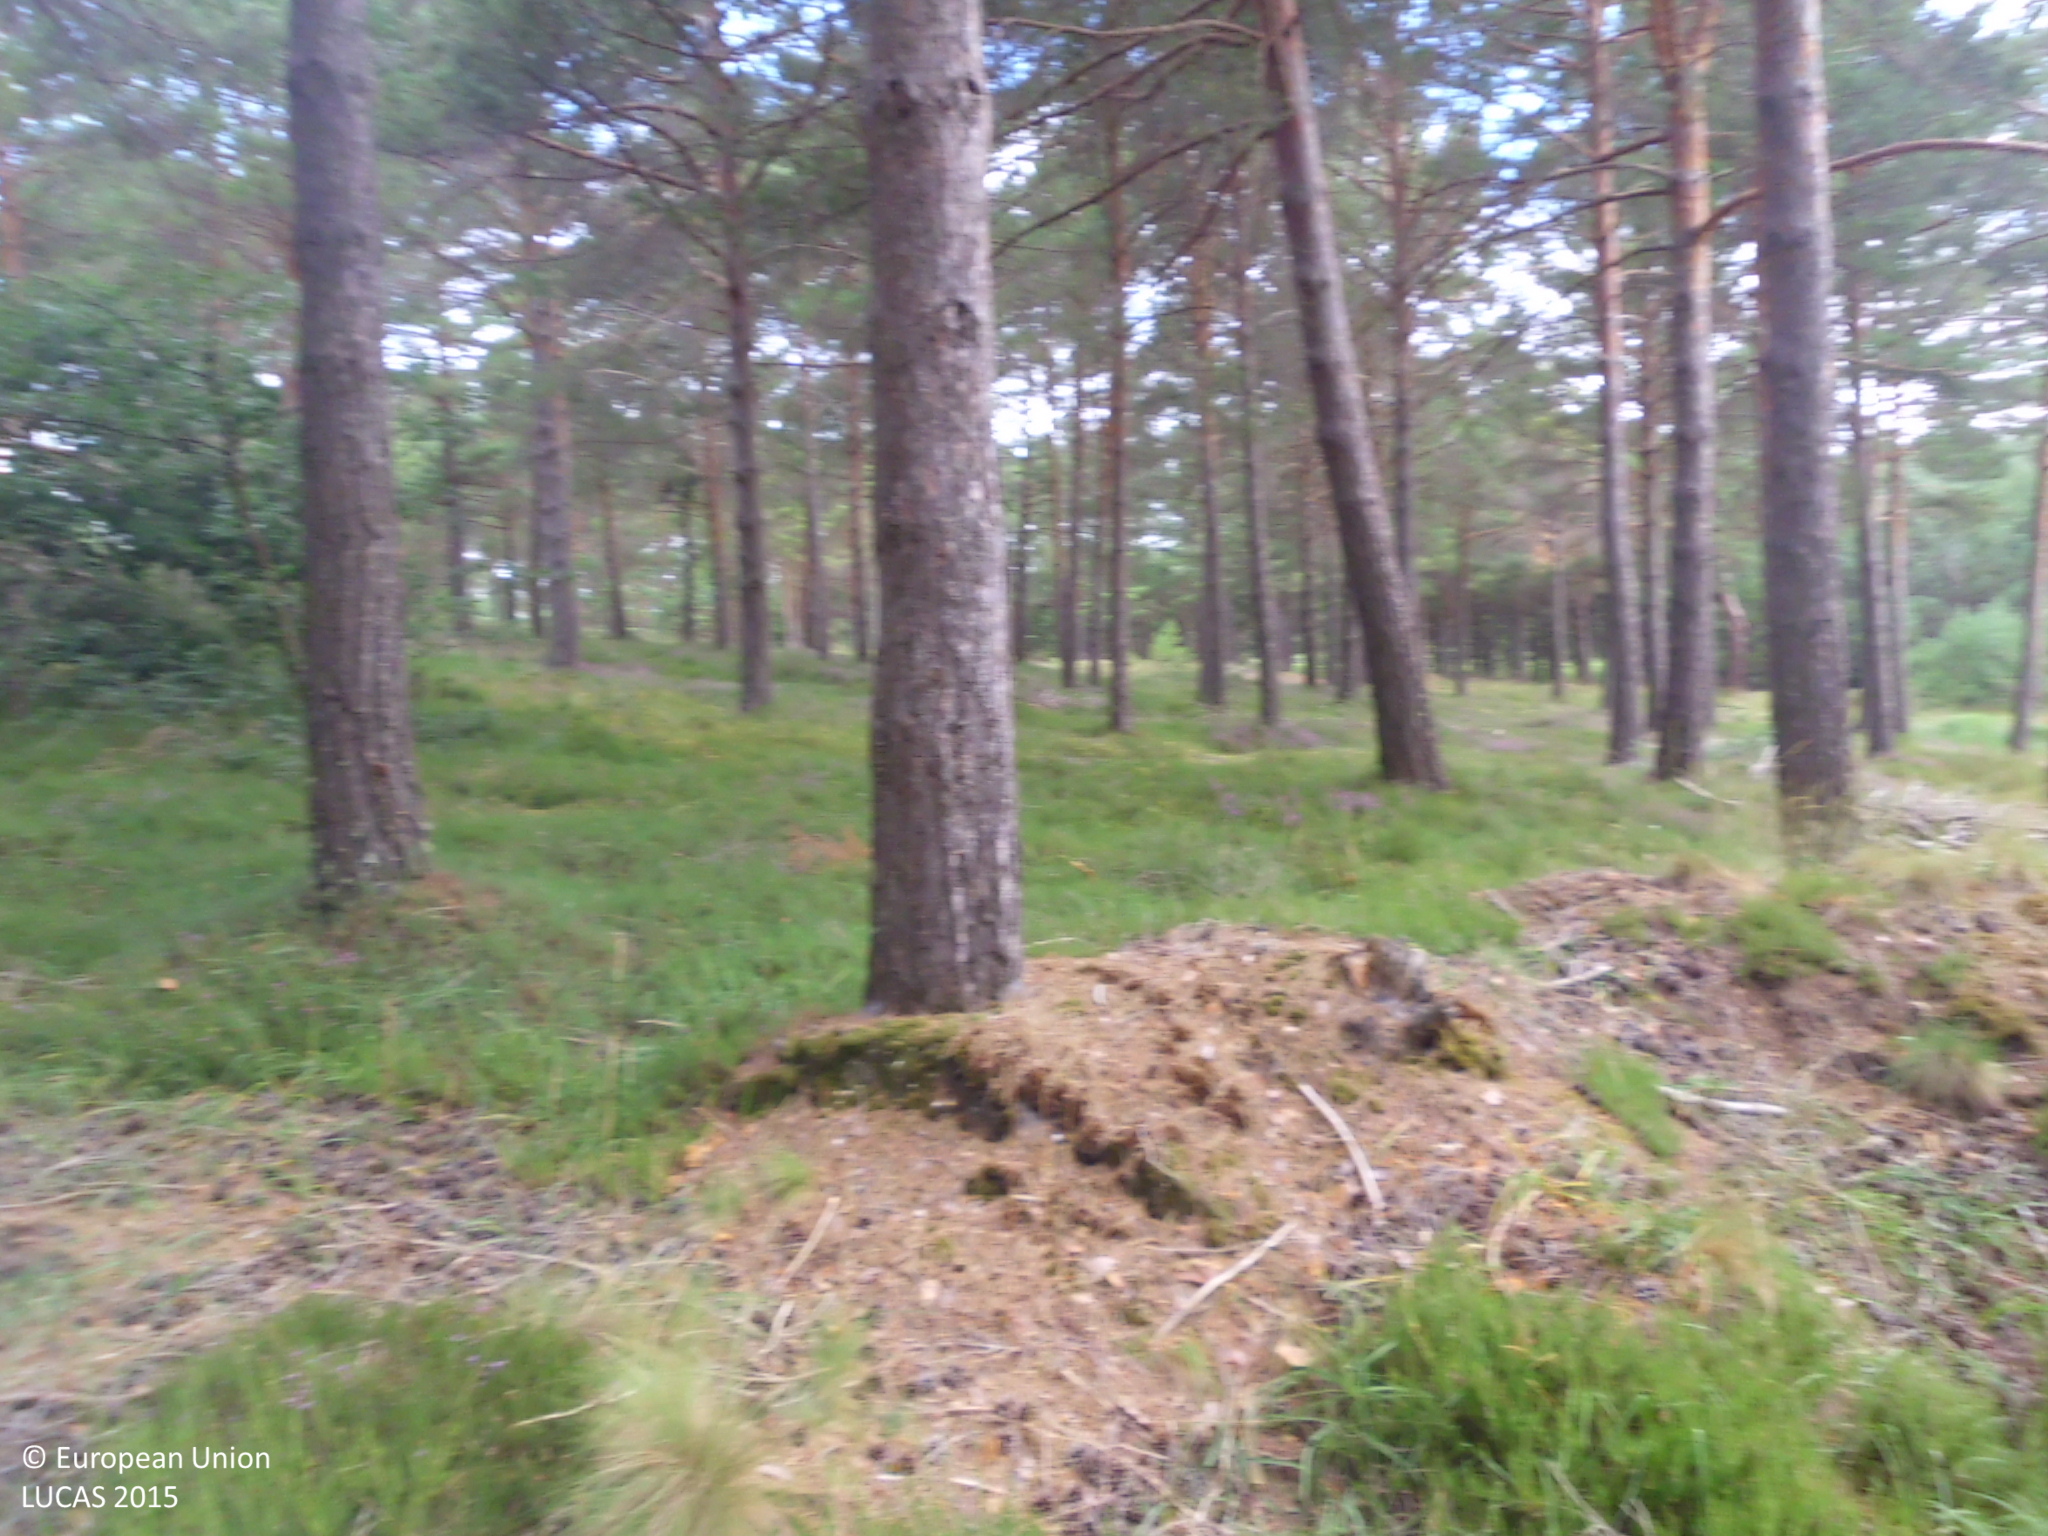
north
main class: Woodland
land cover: Pine dominated coniferous woodland
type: coniferous forest of the mediterranean region
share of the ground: > 75 %
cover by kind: coniferous forest trees 80 %, consolidated bare surface 15 %, shrubs 5 %
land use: Forestry
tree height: > 5 m
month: July
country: ES
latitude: 42.6835
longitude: -3.9940
